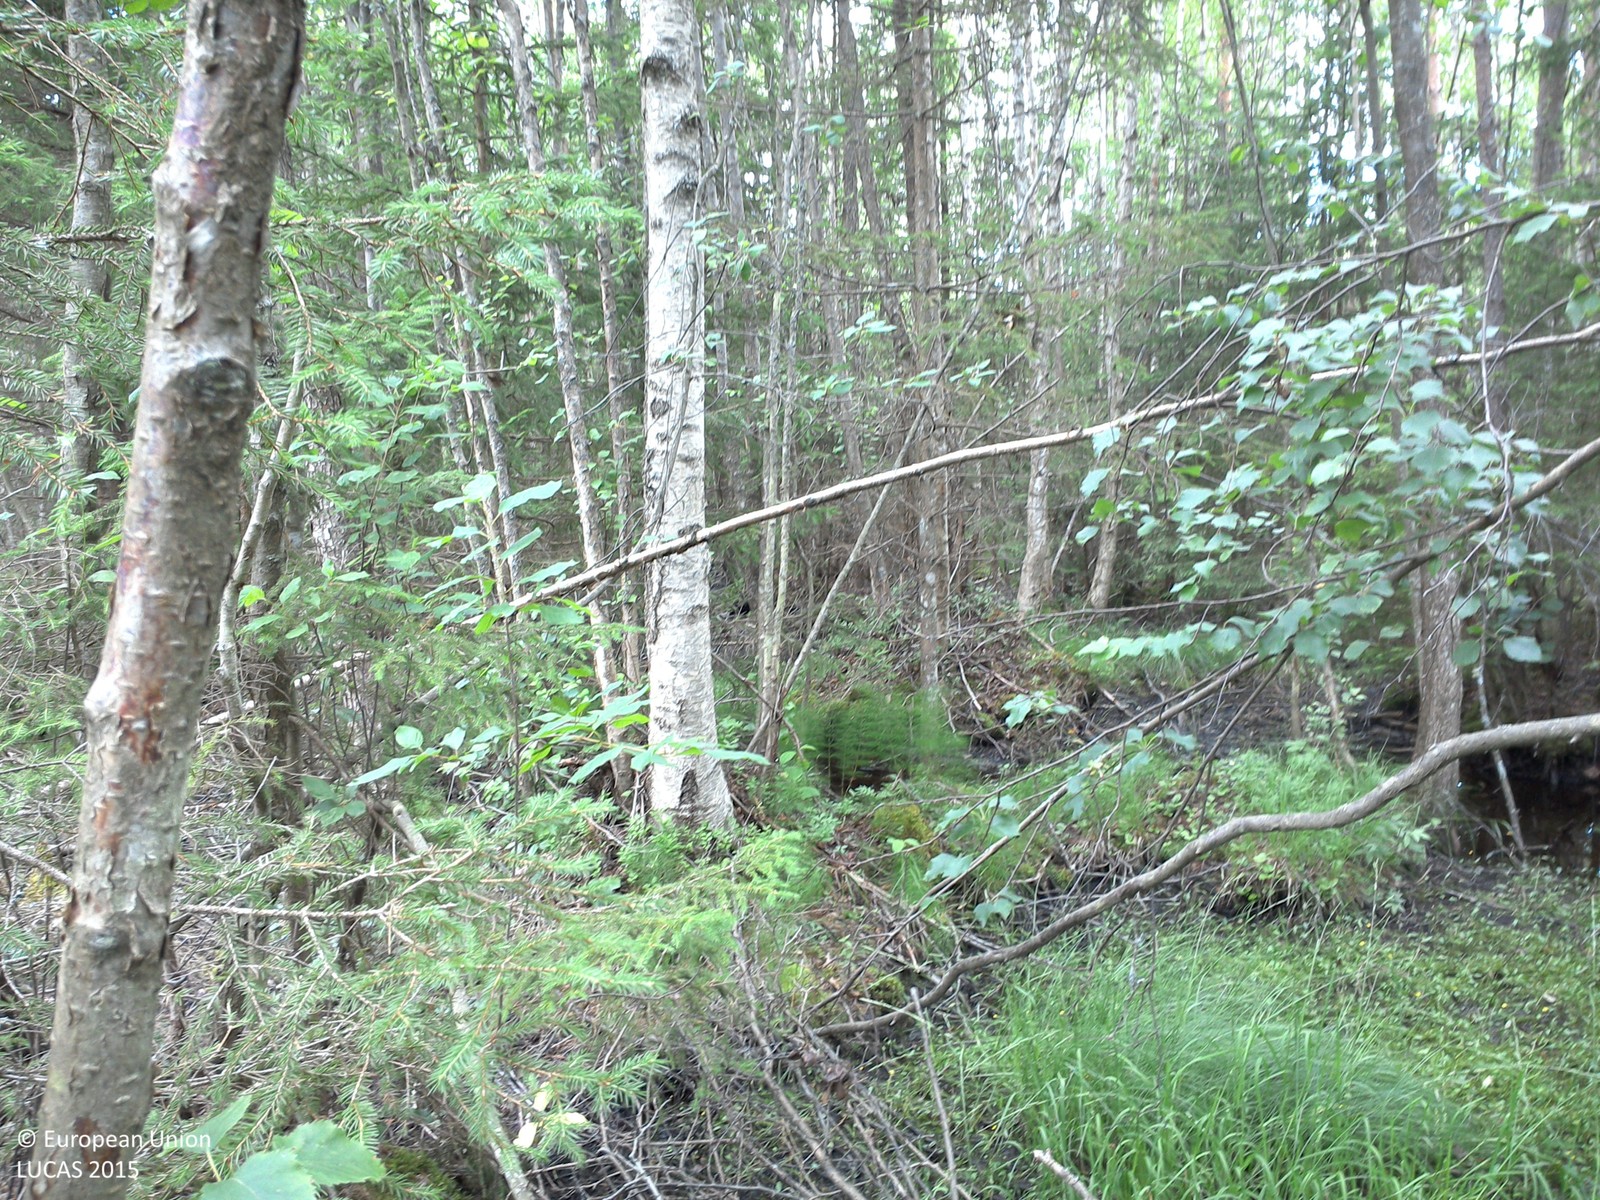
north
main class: Woodland
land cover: Broadleaved woodland
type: mire and swamp forests
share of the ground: 50 - 75 %
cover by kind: broadleaved forest trees 60 %, herbaceous plants 40 %
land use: Forestry
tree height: > 5 m
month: July
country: SE
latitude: 57.9317
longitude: 14.9092
